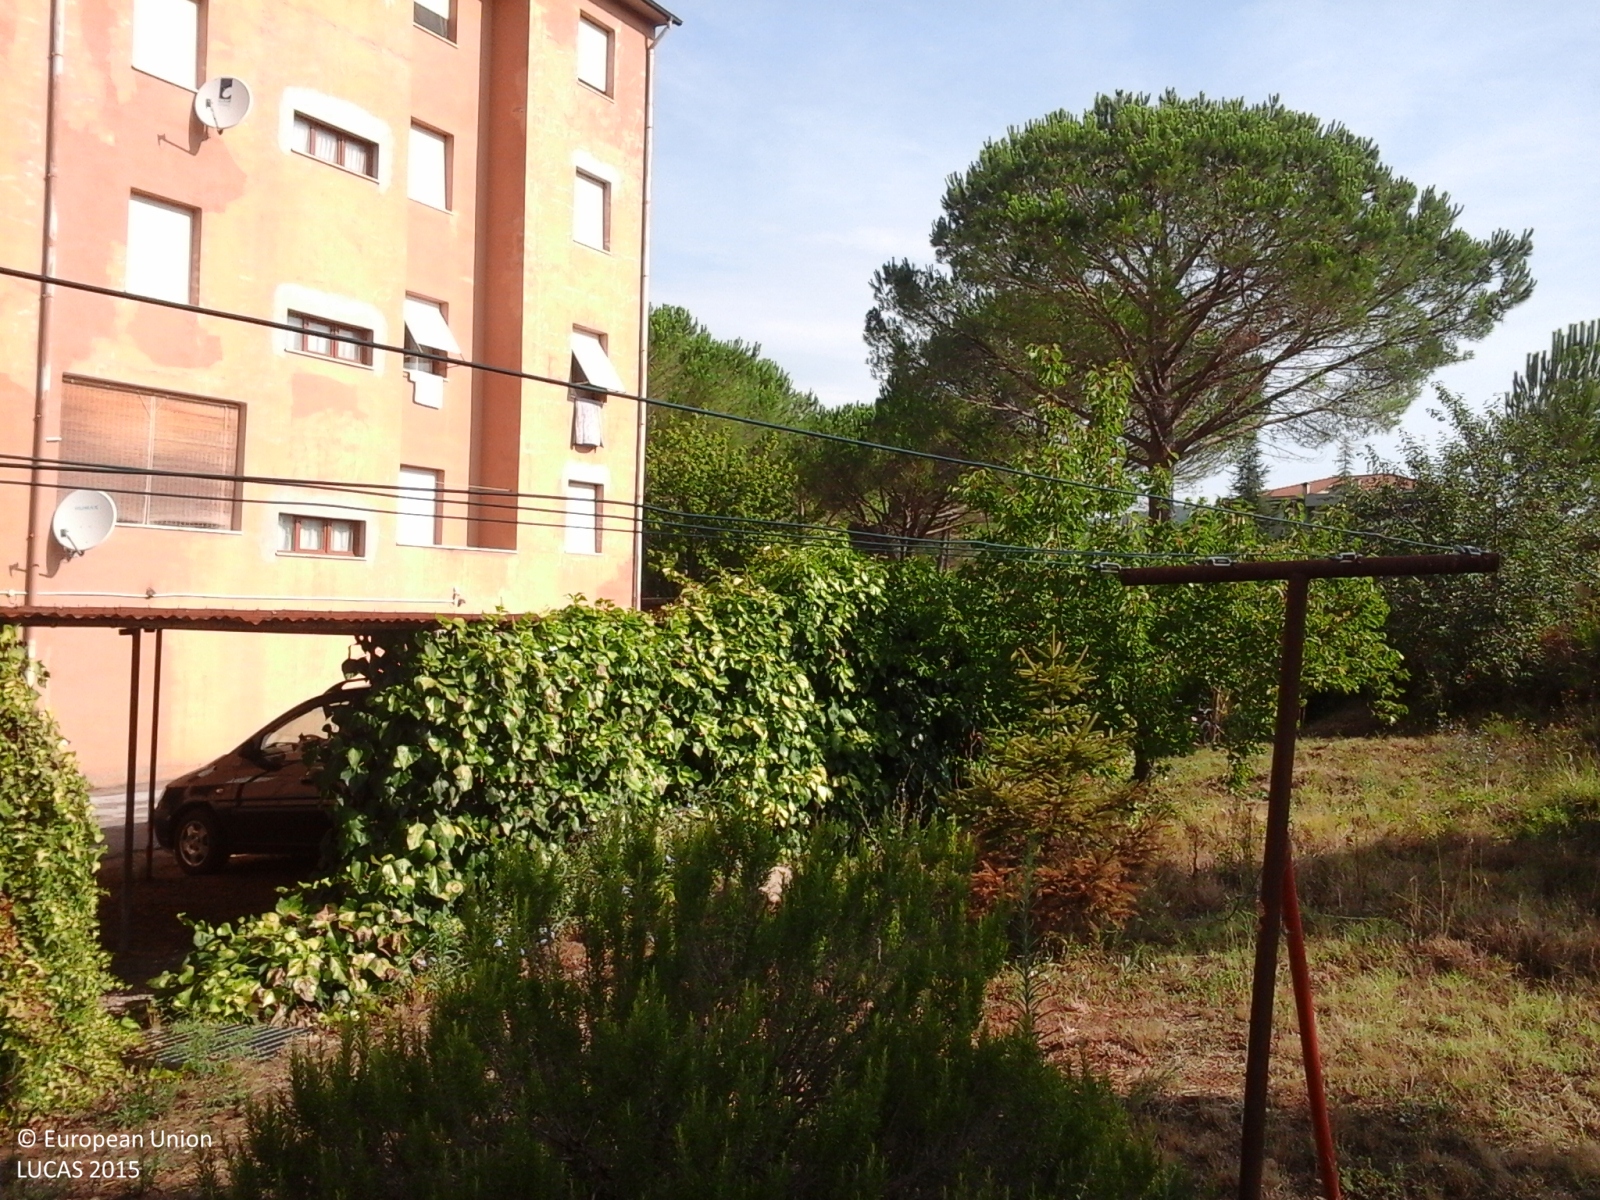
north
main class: Grassland
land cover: Grassland with sparse tree/shrub cover
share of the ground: > 75 %
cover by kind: herbaceous plants 95 %, coniferous forest trees 5 %
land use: Residential
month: August
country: IT
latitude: 42.9391
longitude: 10.8918
